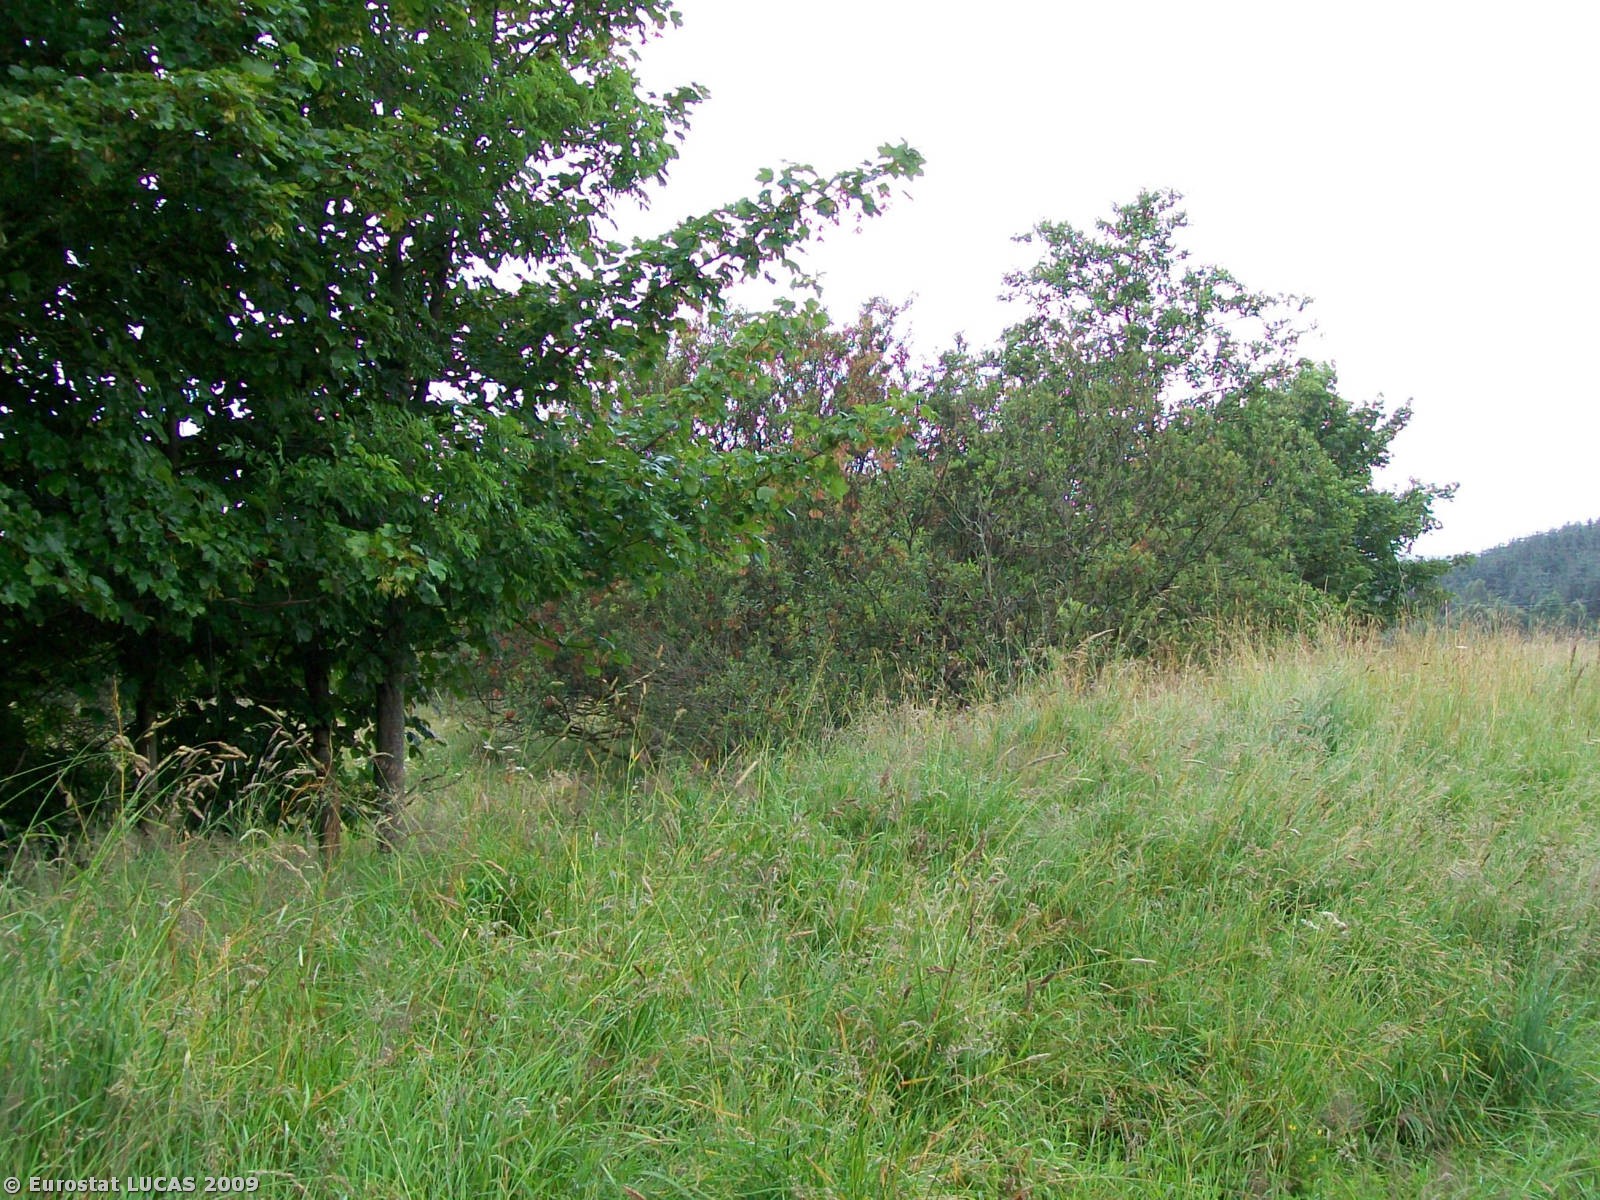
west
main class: Woodland
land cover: Broadleaved woodland
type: floodplain forest
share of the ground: > 75 %
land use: Agriculture (excluding fallow land and kitchen gardens)
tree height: > 5 m
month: July
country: GB
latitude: 55.1612
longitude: -3.9809
